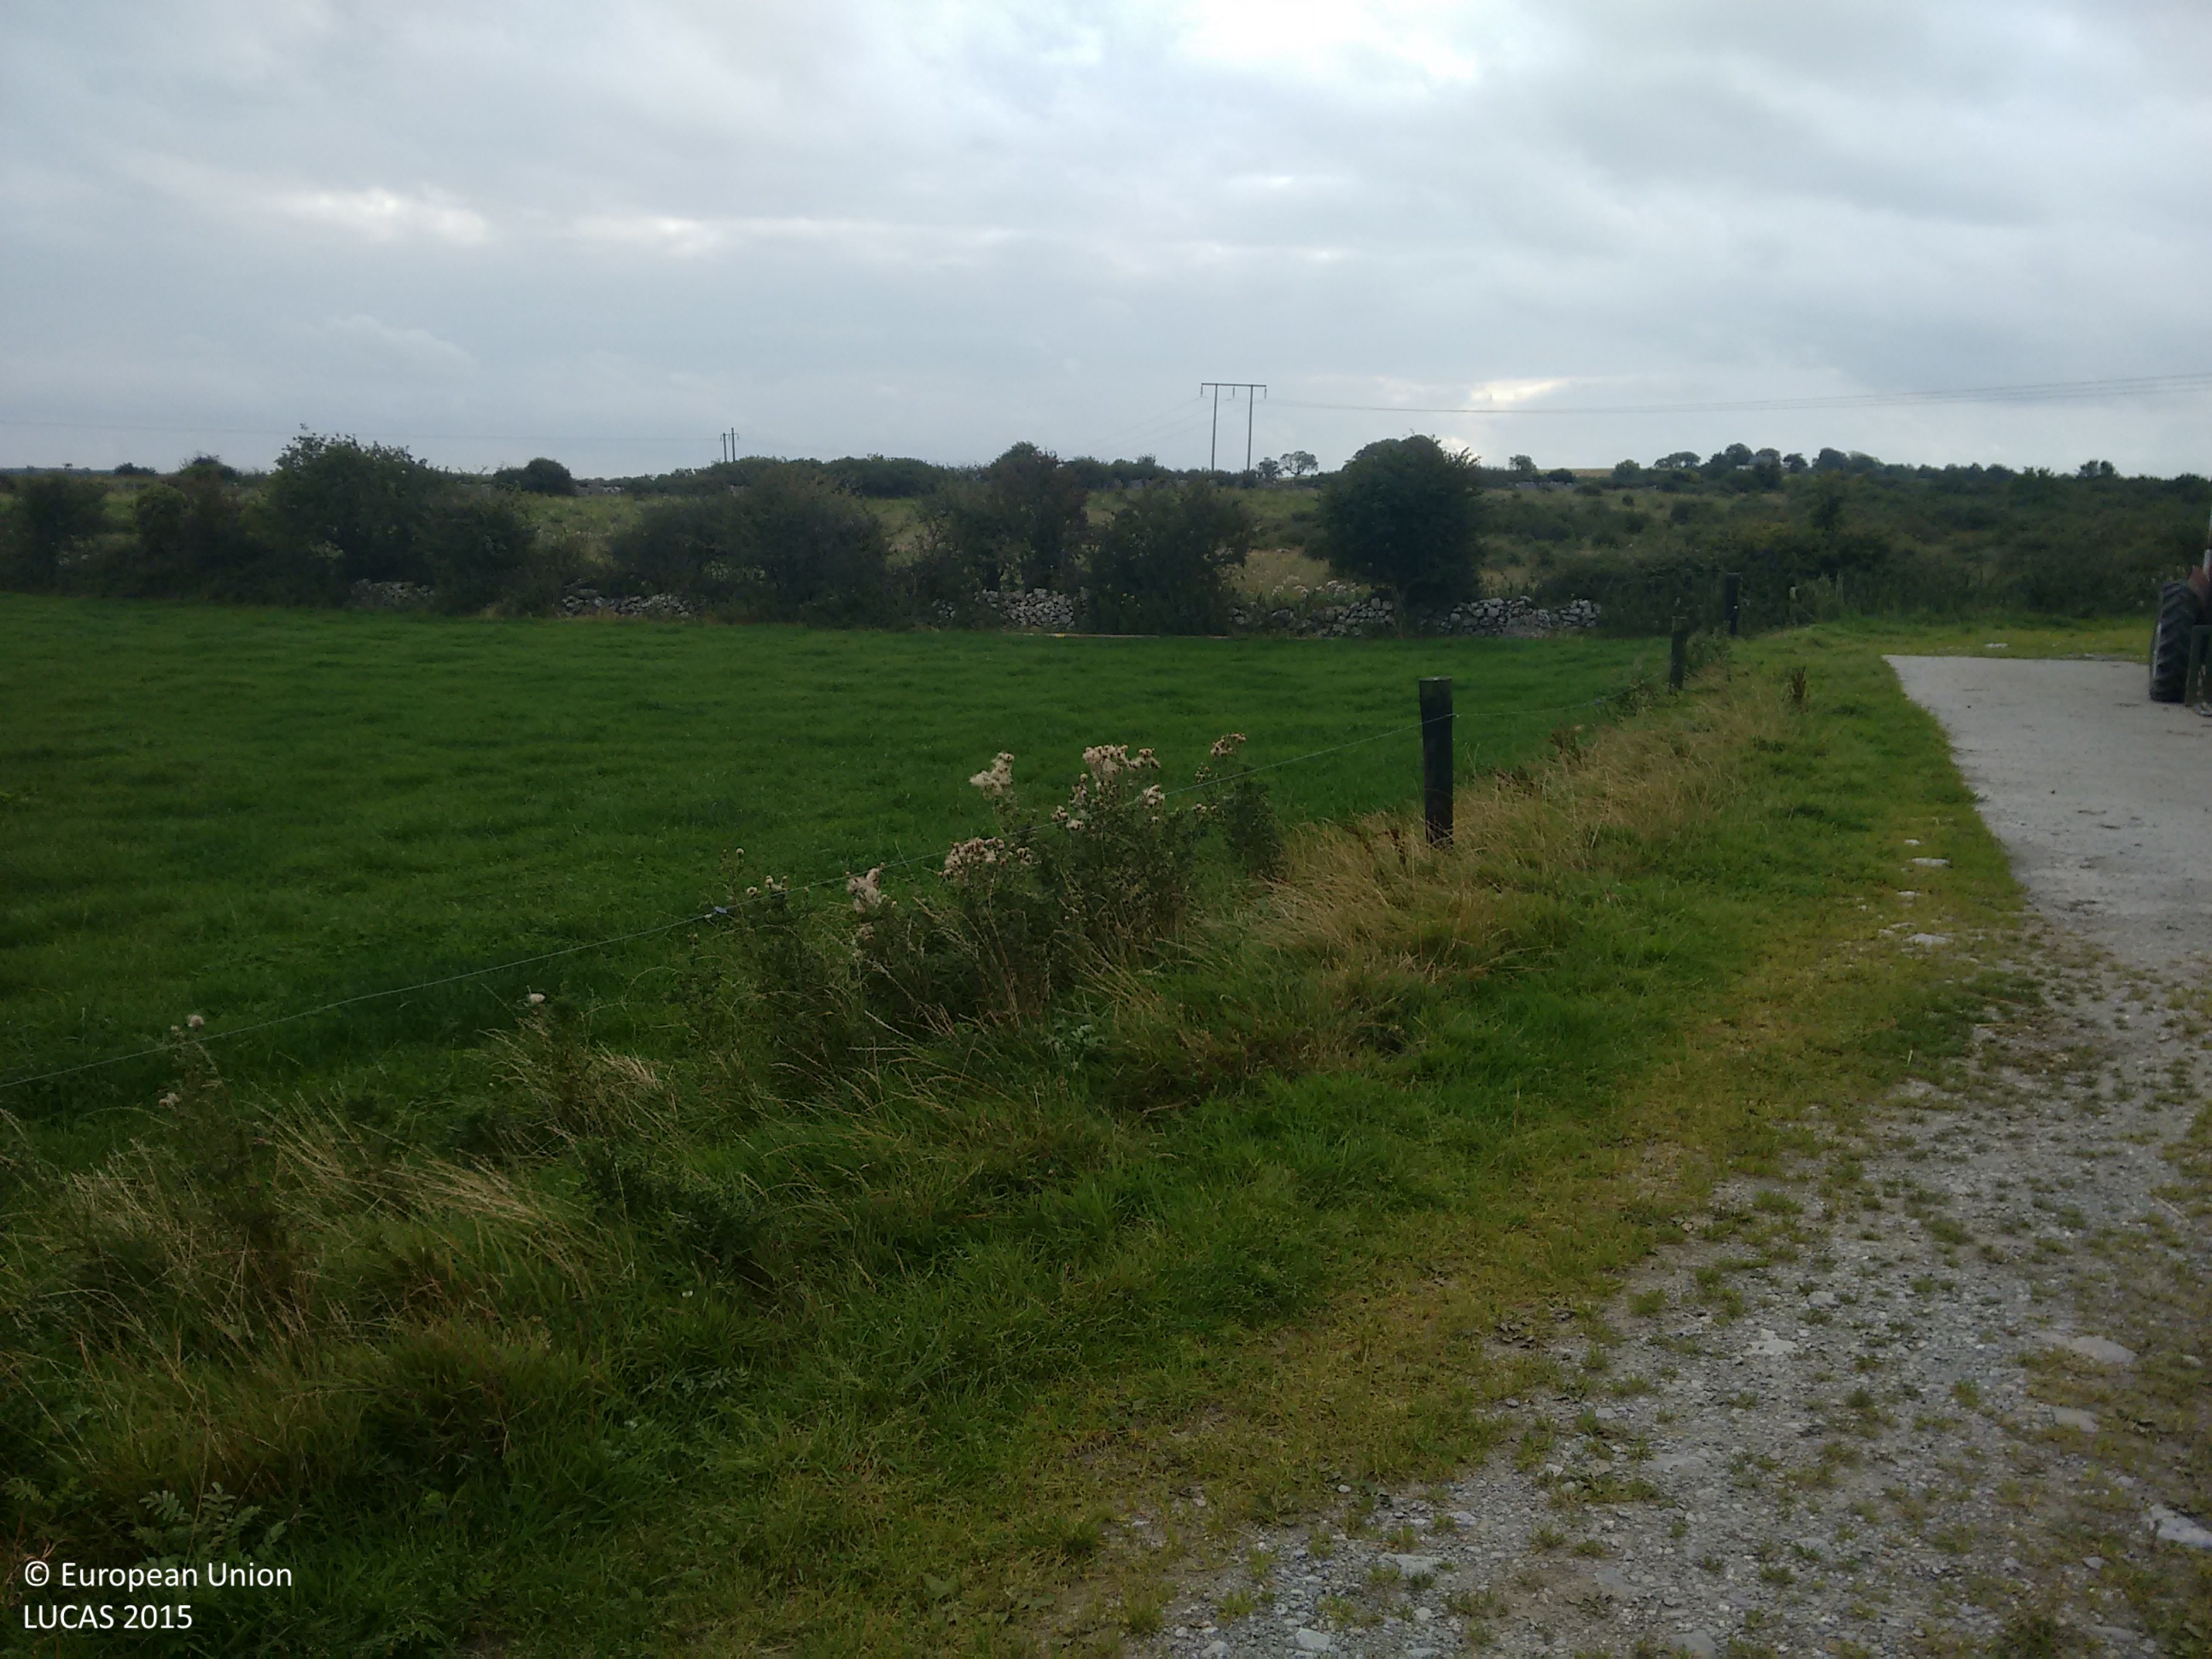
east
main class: Grassland
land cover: Grassland with sparse tree/shrub cover
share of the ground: > 75 %
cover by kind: herbaceous plants 95 %, broadleaved forest trees 5 %
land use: Agriculture (excluding fallow land and kitchen gardens)
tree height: > 5 m
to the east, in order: Grassland with sparse tree/shrub cover; Abandoned hedges; Grassland with sparse tree/shrub cover; Electric lines; Grassland with sparse tree/shrub cover; Dry stone walls; Shrubland without tree cover; Spontaneously vegetated surfaces
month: September
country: IE
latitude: 52.5703
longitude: -9.0566
